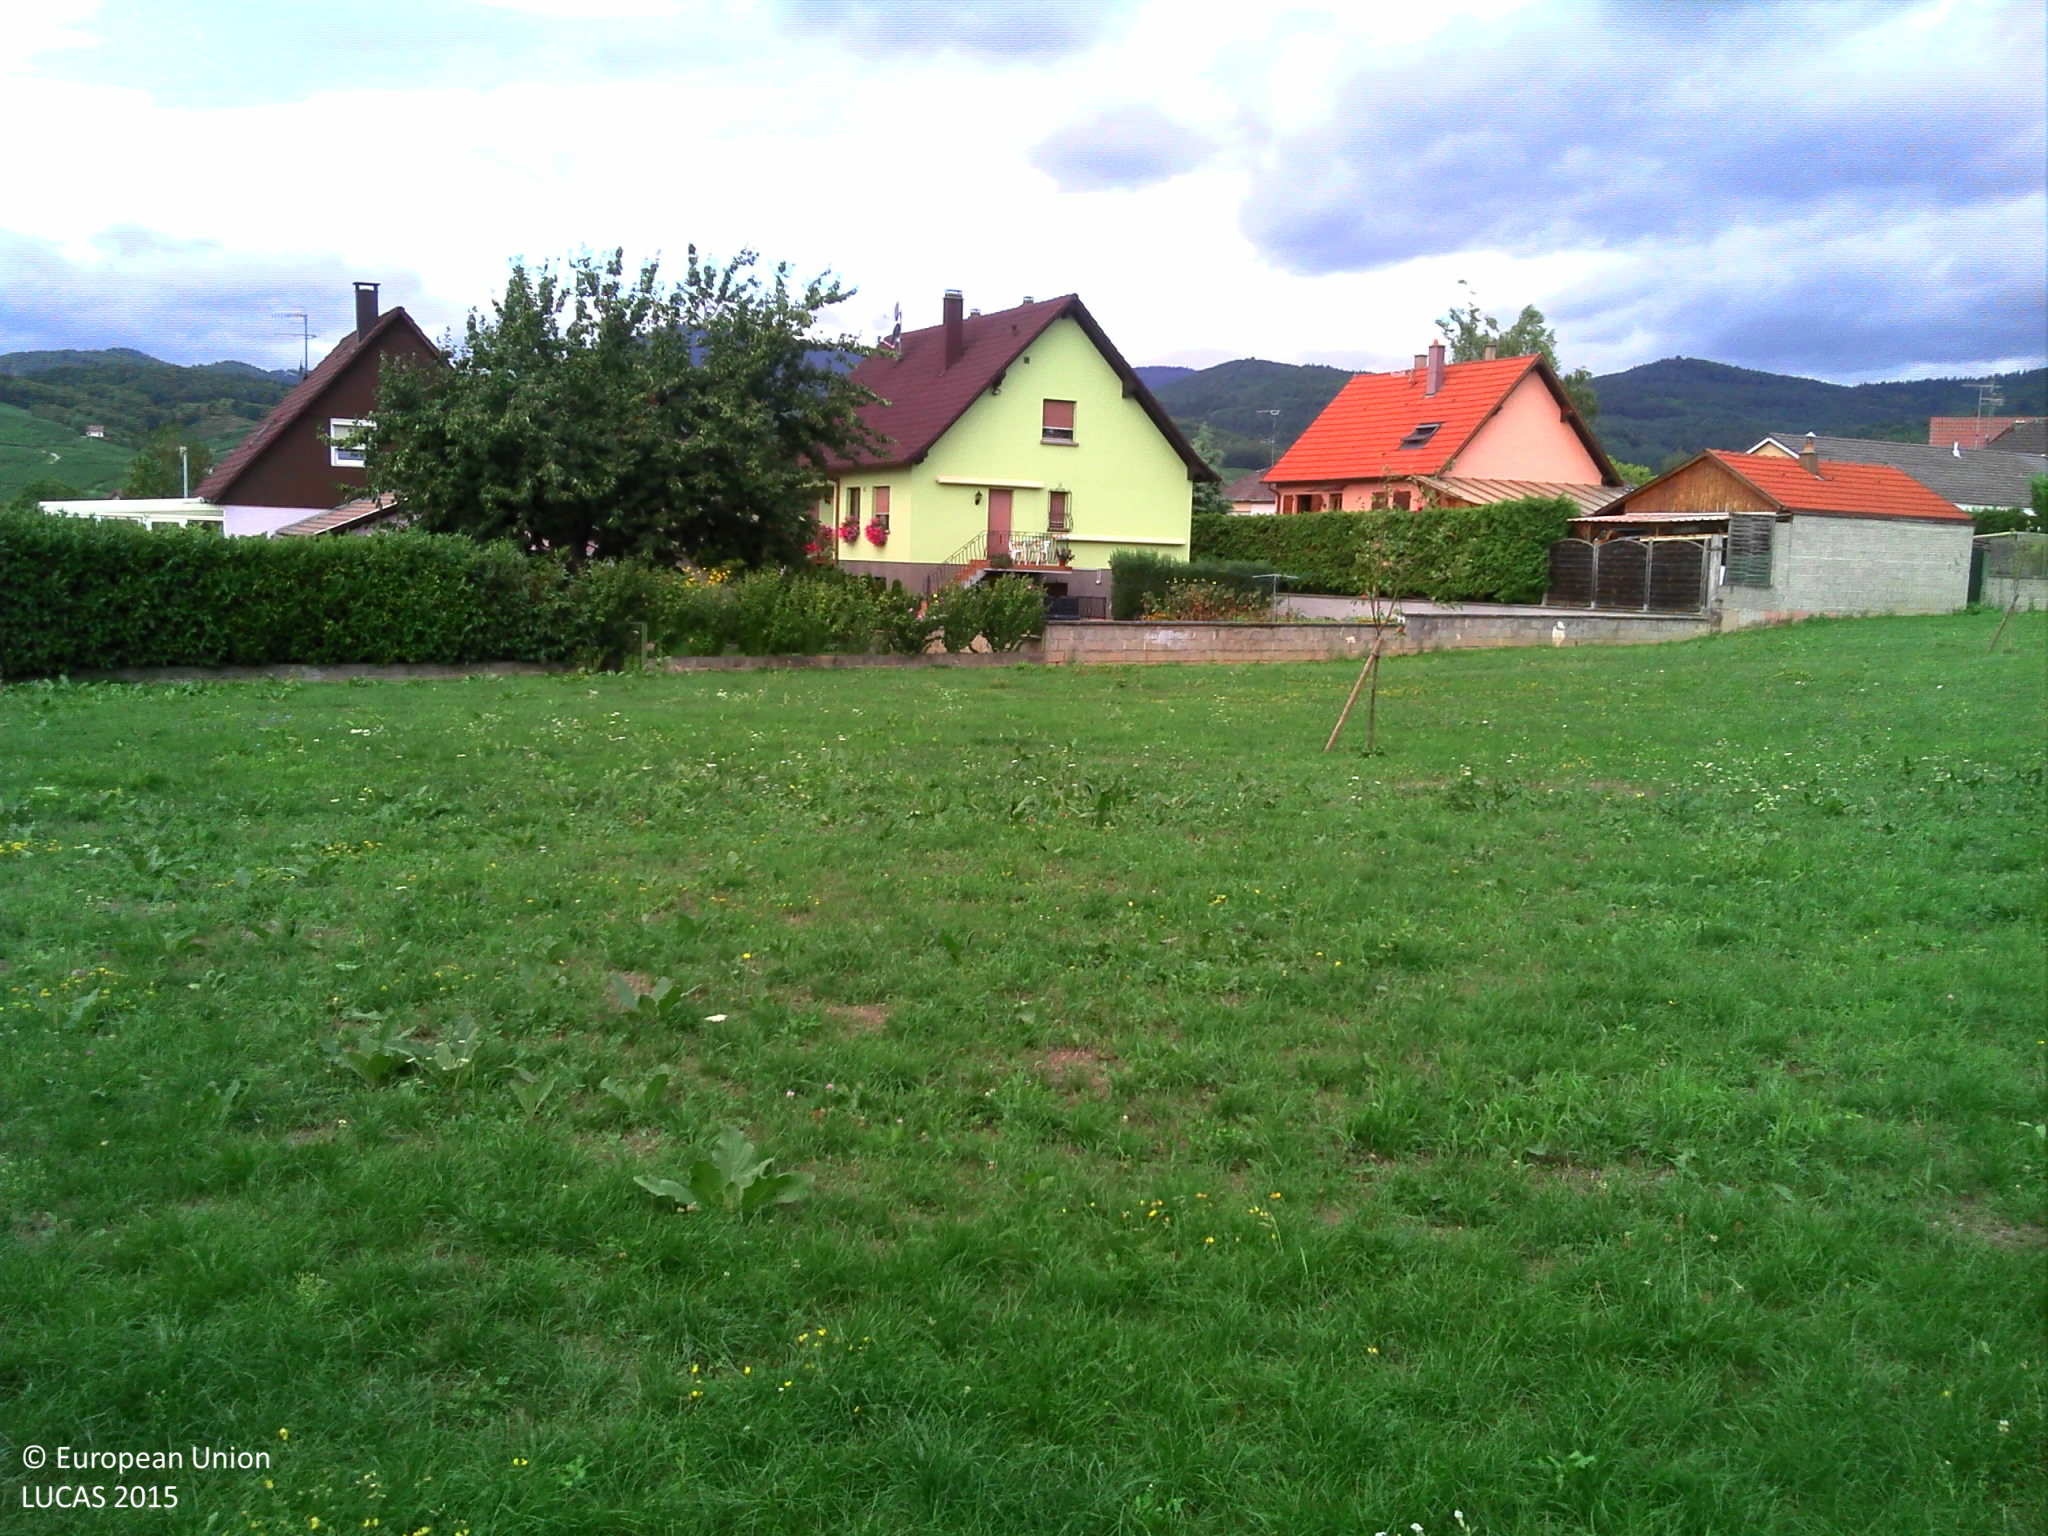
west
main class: Grassland
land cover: Grassland without tree/shrub cover
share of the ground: > 75 %
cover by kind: herbaceous plants 100 %
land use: Agriculture (excluding fallow land and kitchen gardens)
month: September
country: FR
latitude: 48.2283
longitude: 7.3759
